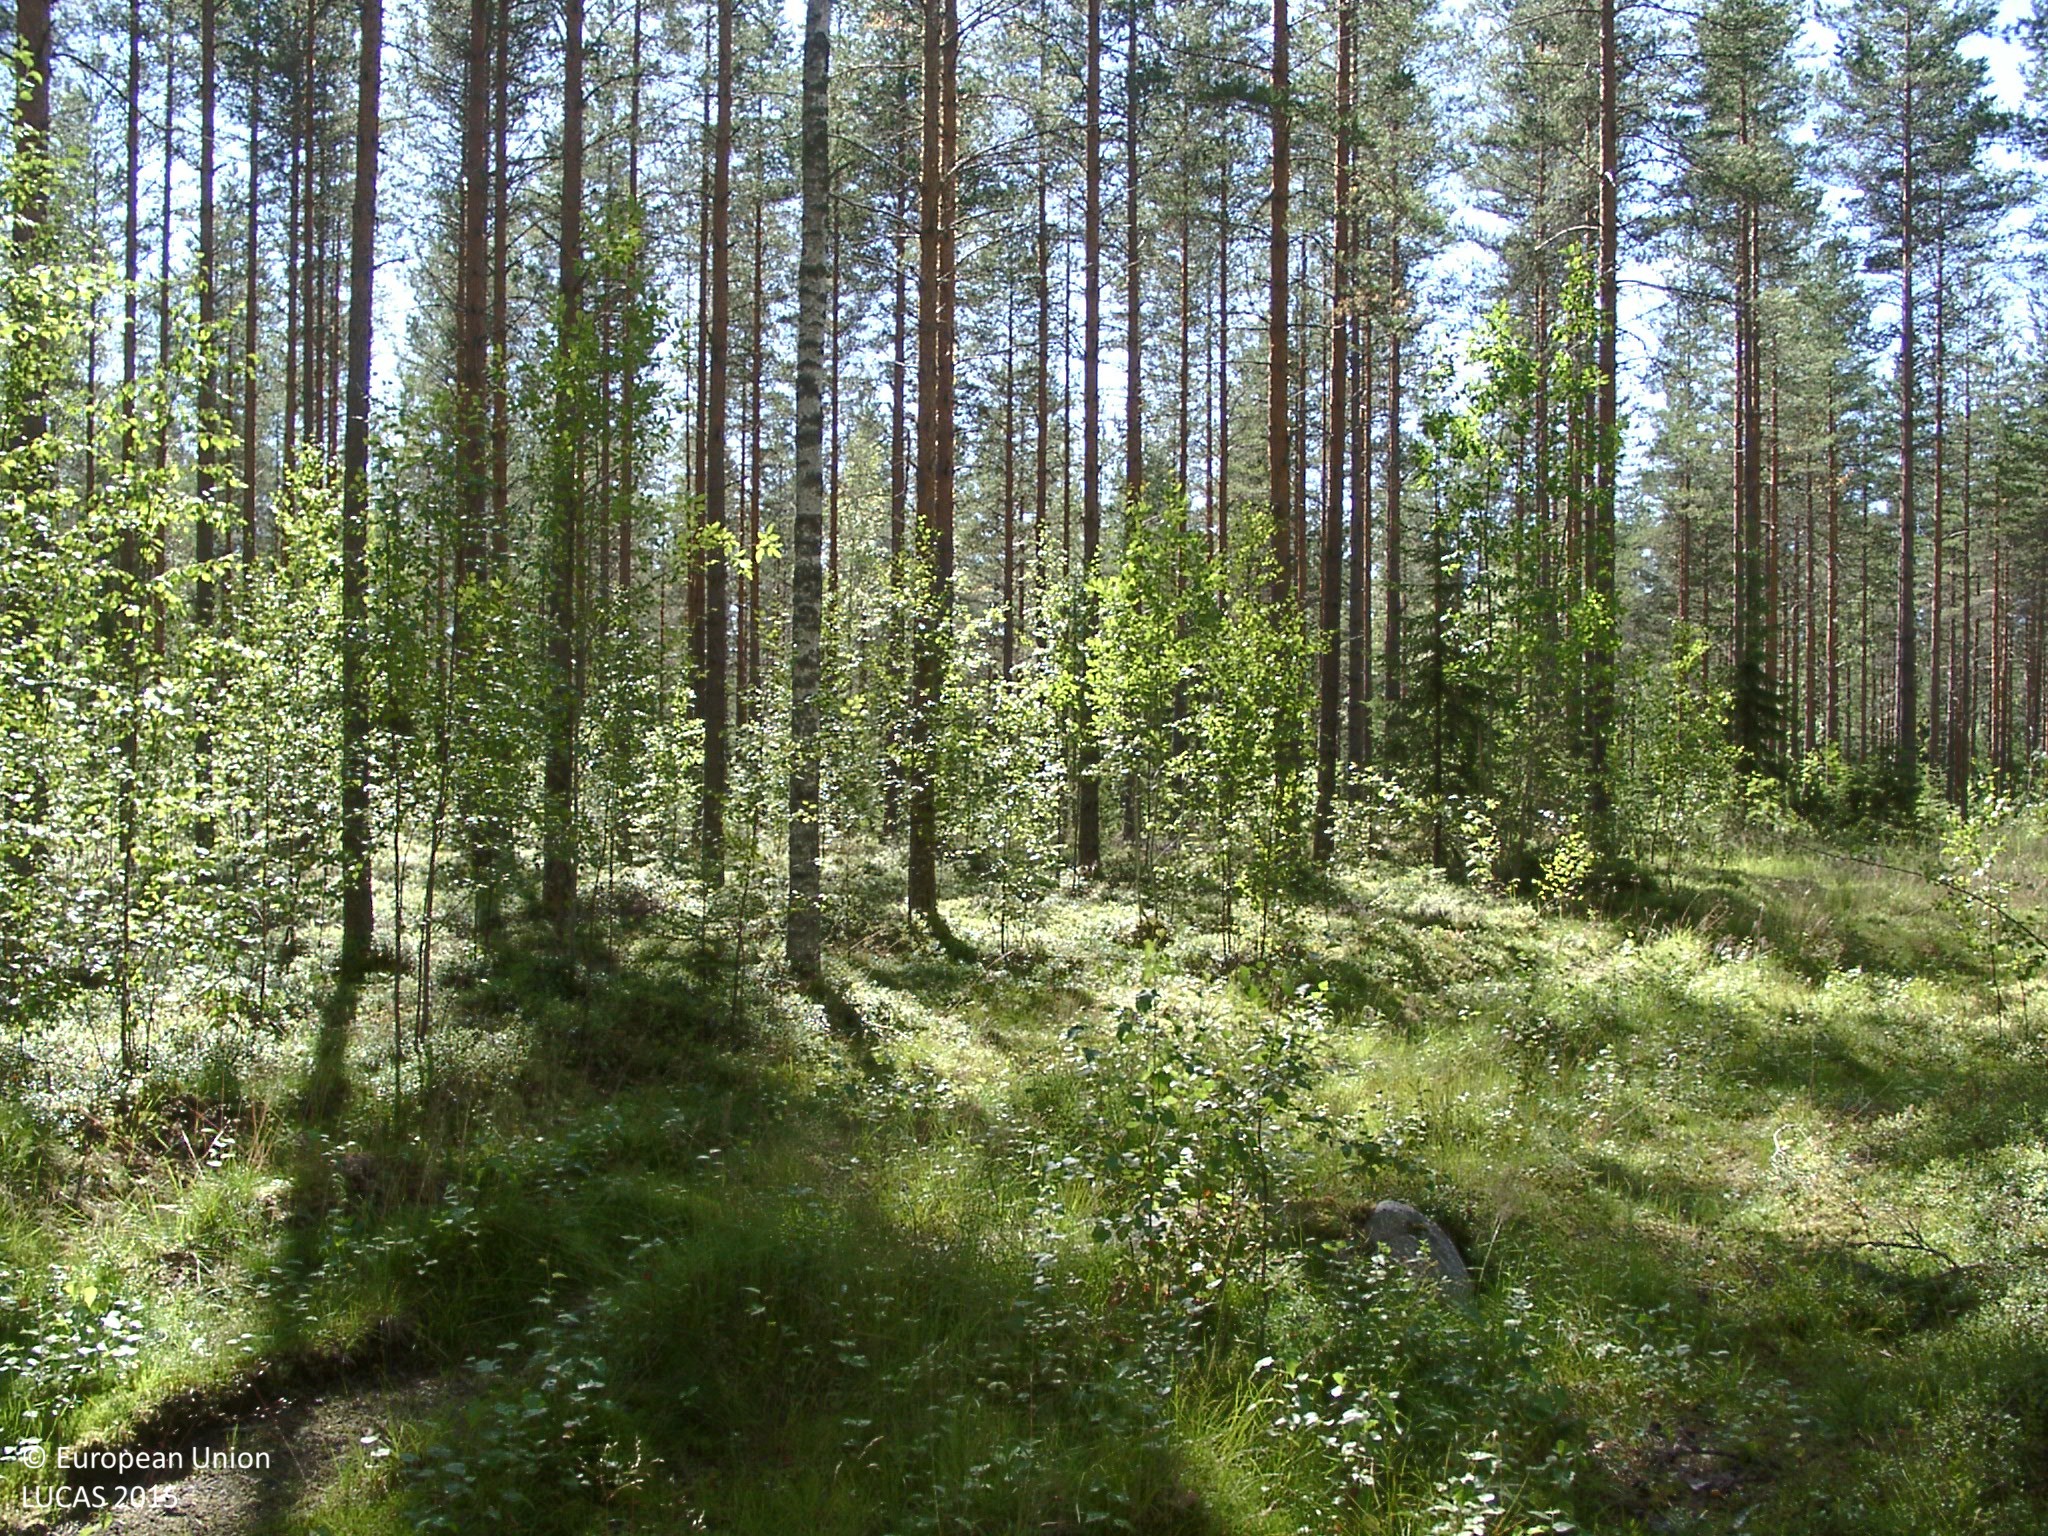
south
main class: Woodland
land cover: Pine dominated coniferous woodland
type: boreal forest
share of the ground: 50 - 75 %
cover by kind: coniferous forest trees 55 %, shrubs 20 %, broadleaved forest trees 15 %, lichens and mosses 10 %
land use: Forestry
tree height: > 5 m
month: August
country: FI
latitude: 62.3606
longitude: 25.2760
